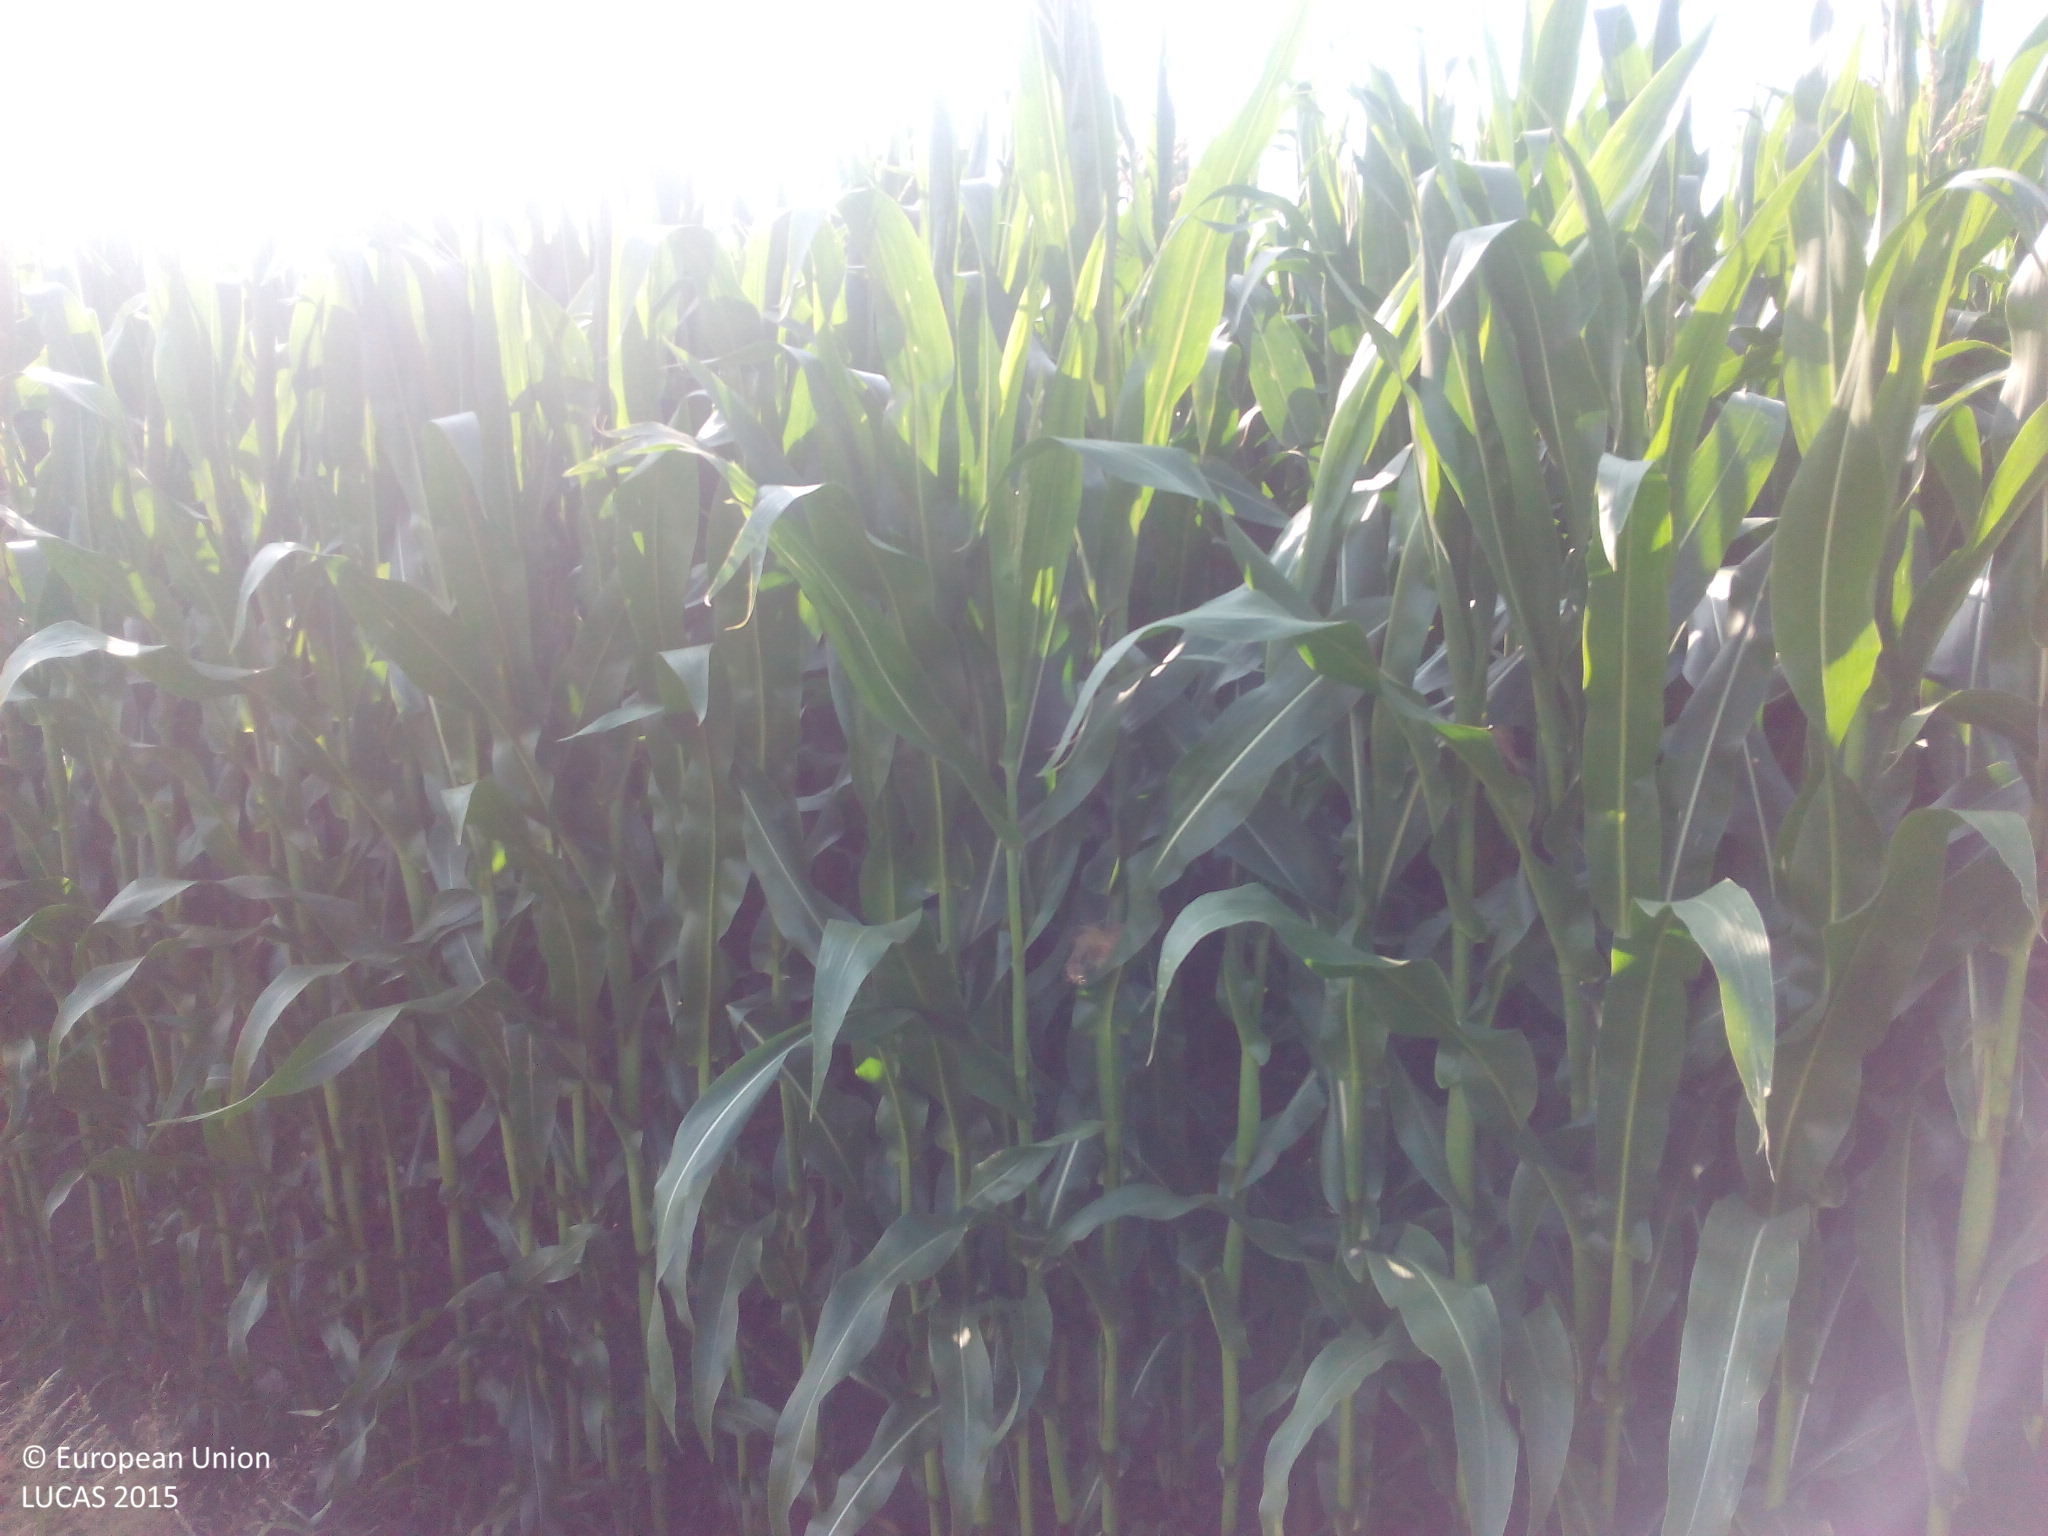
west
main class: Cropland
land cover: Maize
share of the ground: > 75 %
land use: Agriculture (excluding fallow land and kitchen gardens)
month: August
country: DE
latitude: 53.9923
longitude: 9.1921
